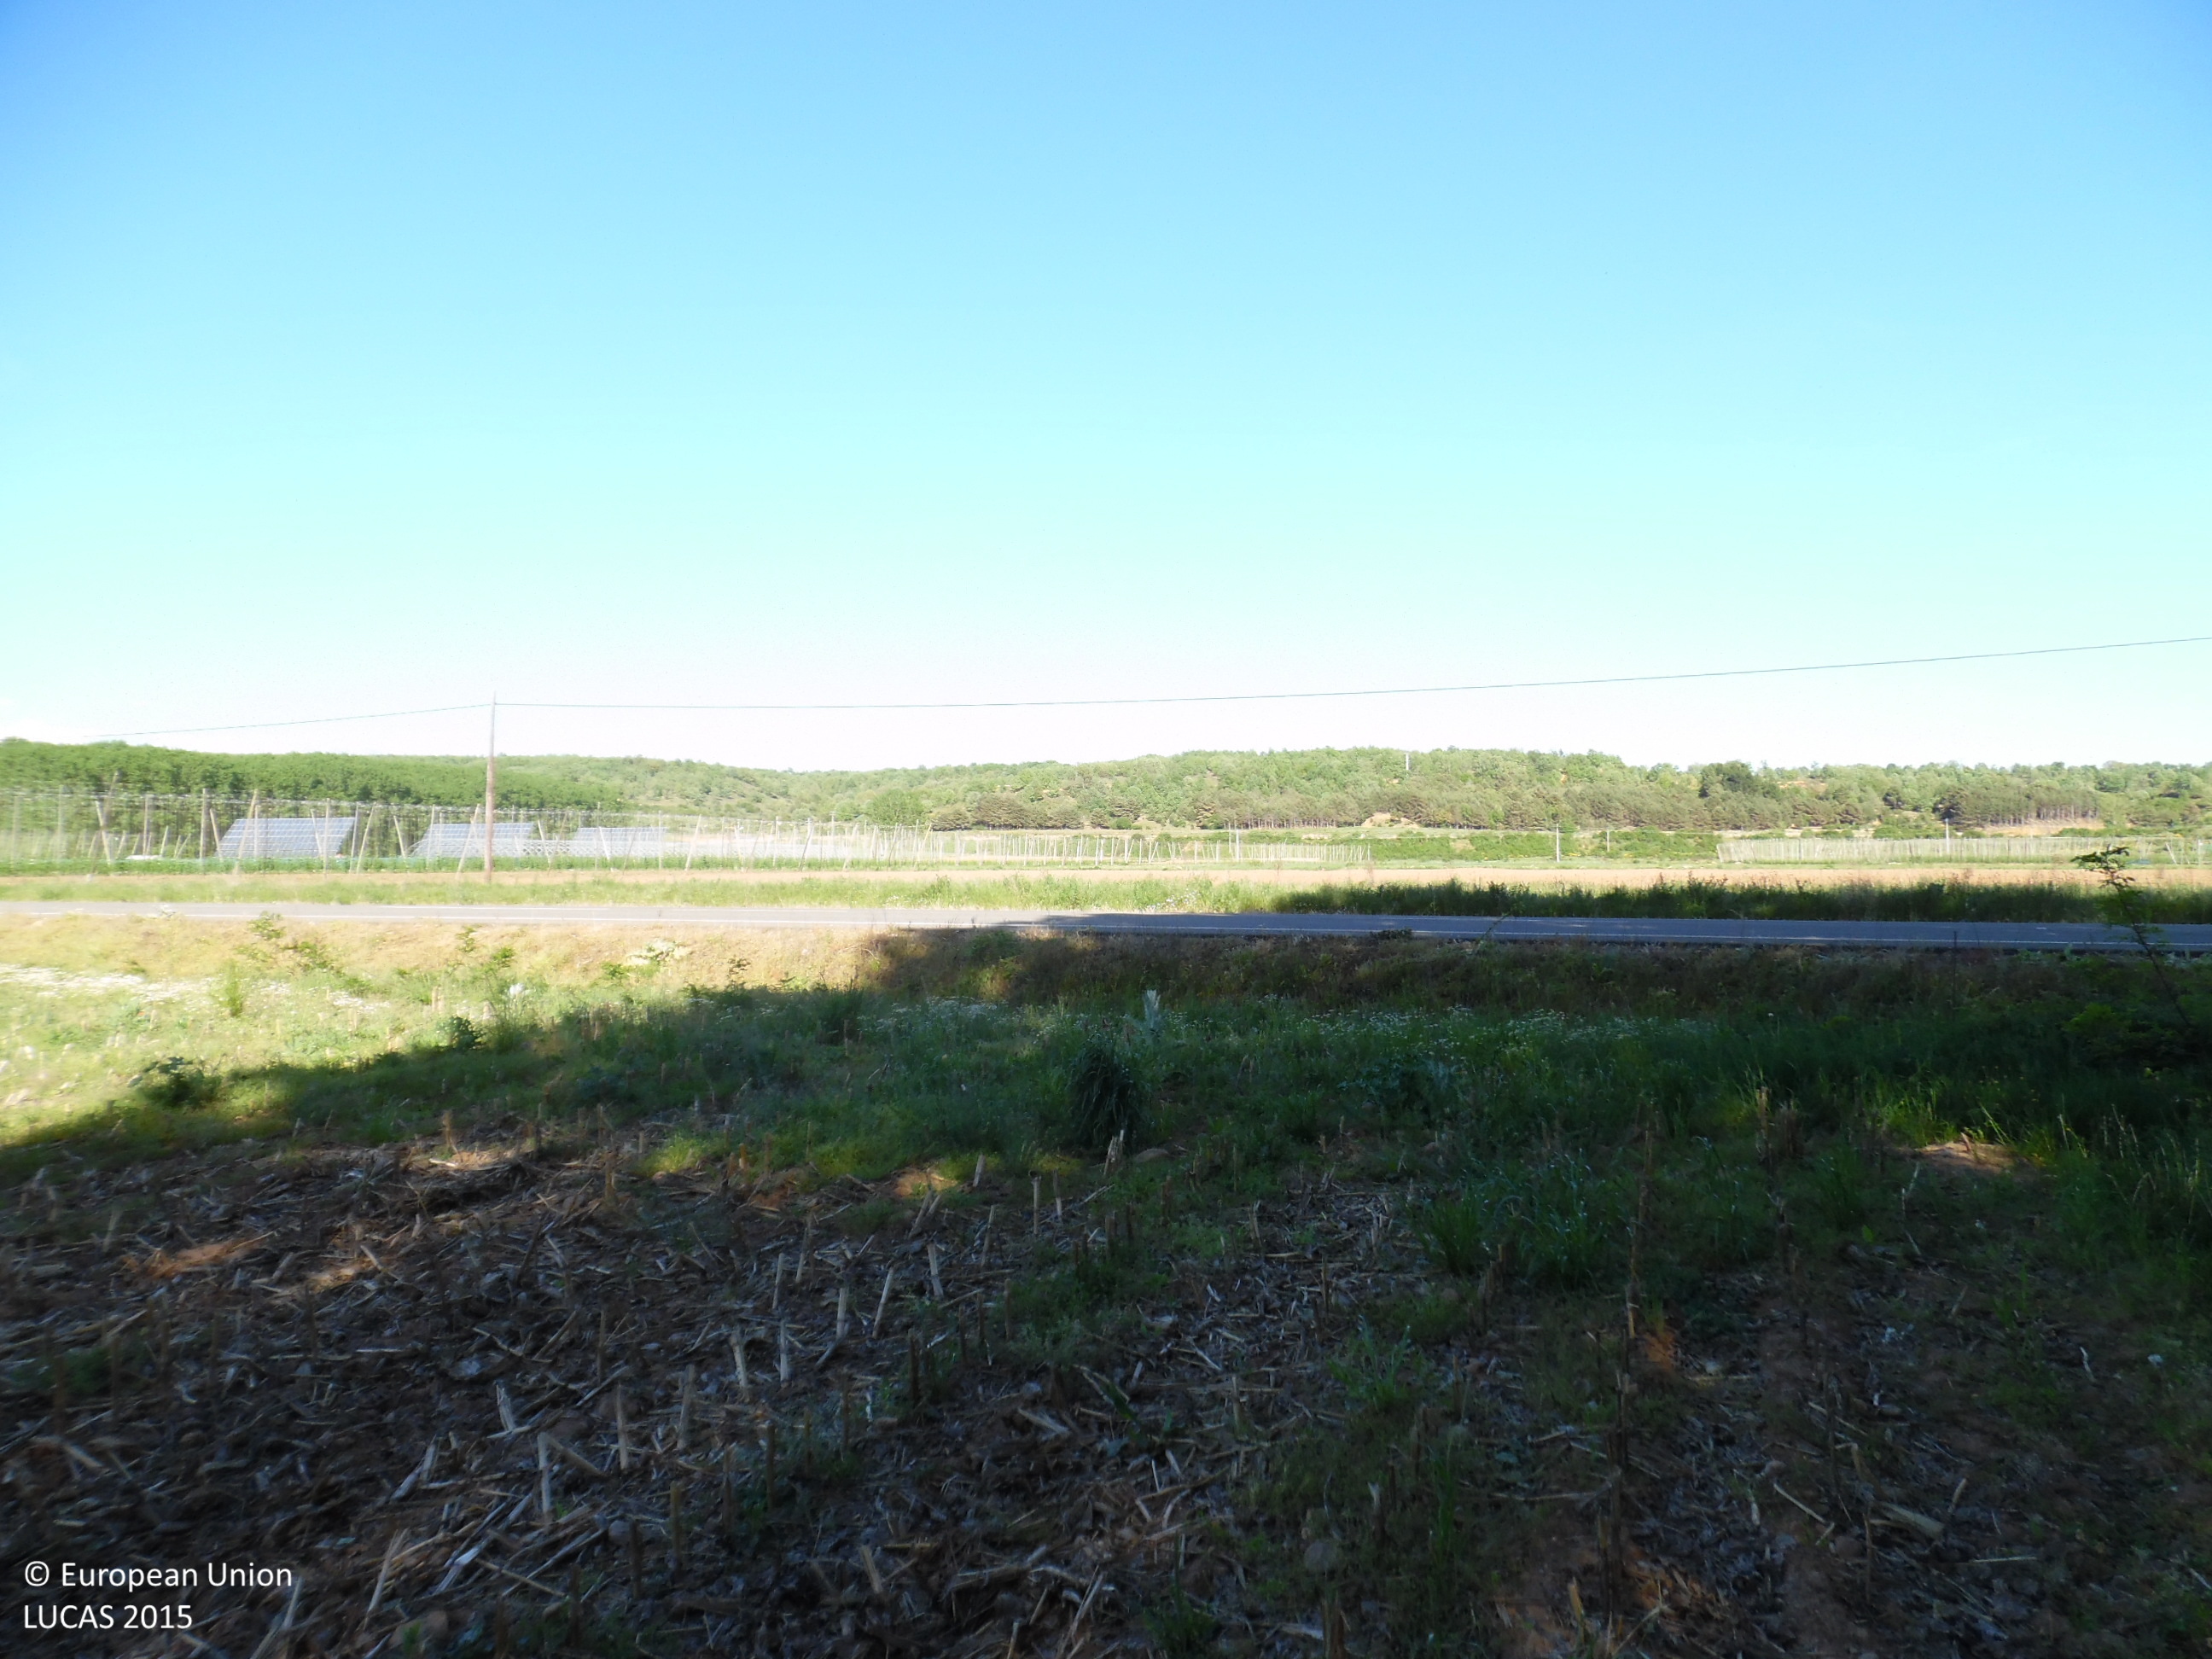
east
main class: Grassland
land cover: Spontaneously vegetated surfaces
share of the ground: 25 - 50 %
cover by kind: herbaceous plants 100 %
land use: Fallow land
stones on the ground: < 10 %
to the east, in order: Spontaneously vegetated surfaces; Grass margins; Paved roads, cycling and walking lanes; Grass margins; Tracks; Grass margins; Ditches and canals; Grass margins; Maize; Electric lines; Maize; Grass margins; Tracks; Grass margins; Ditches and canals; Grass margins; Temporary grasslands
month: May
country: ES
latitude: 42.5967
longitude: -5.8117
